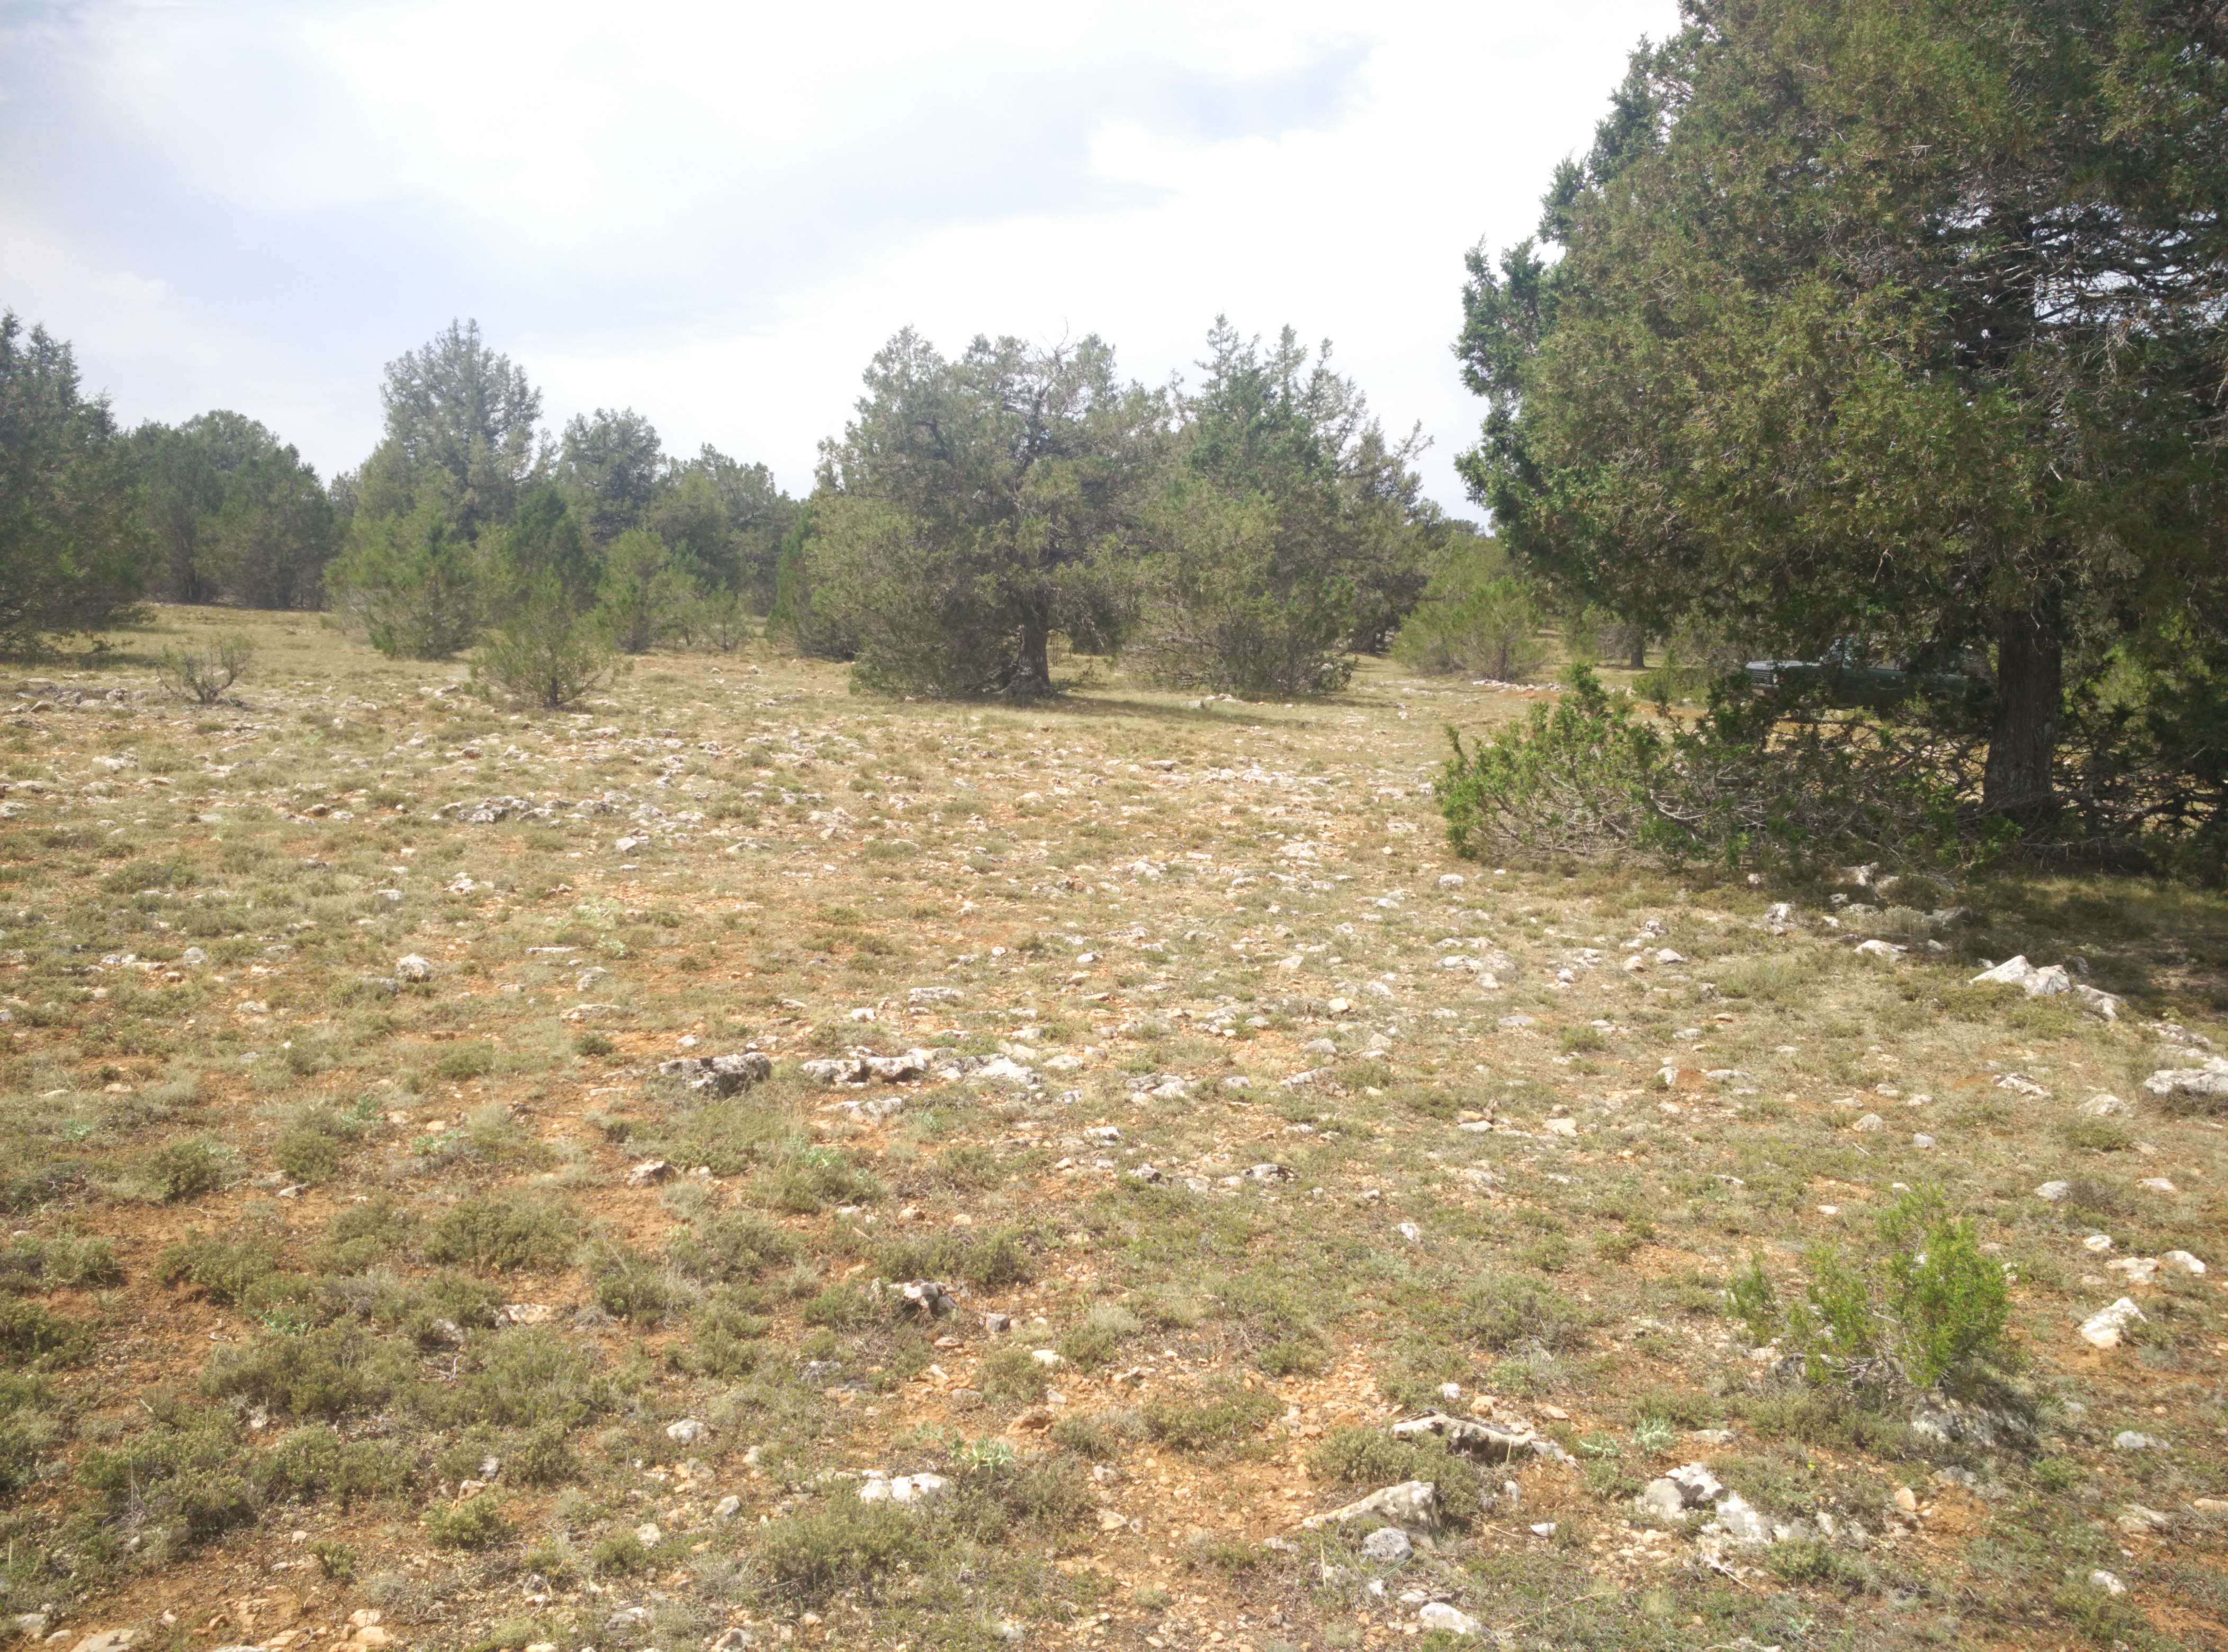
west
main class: Woodland
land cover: Other coniferous woodland
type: coniferous forest of the mediterranean region
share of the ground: 10 - 25 %
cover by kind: unconsolidated bare surface 55 %, shrubs 20 %, coniferous forest trees 15 %, herbaceous plants 5 %, lichens and mosses 5 %
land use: Semi-natural and natural areas not in use
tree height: > 5 m
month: July
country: ES
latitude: 40.8948
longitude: -2.0242
